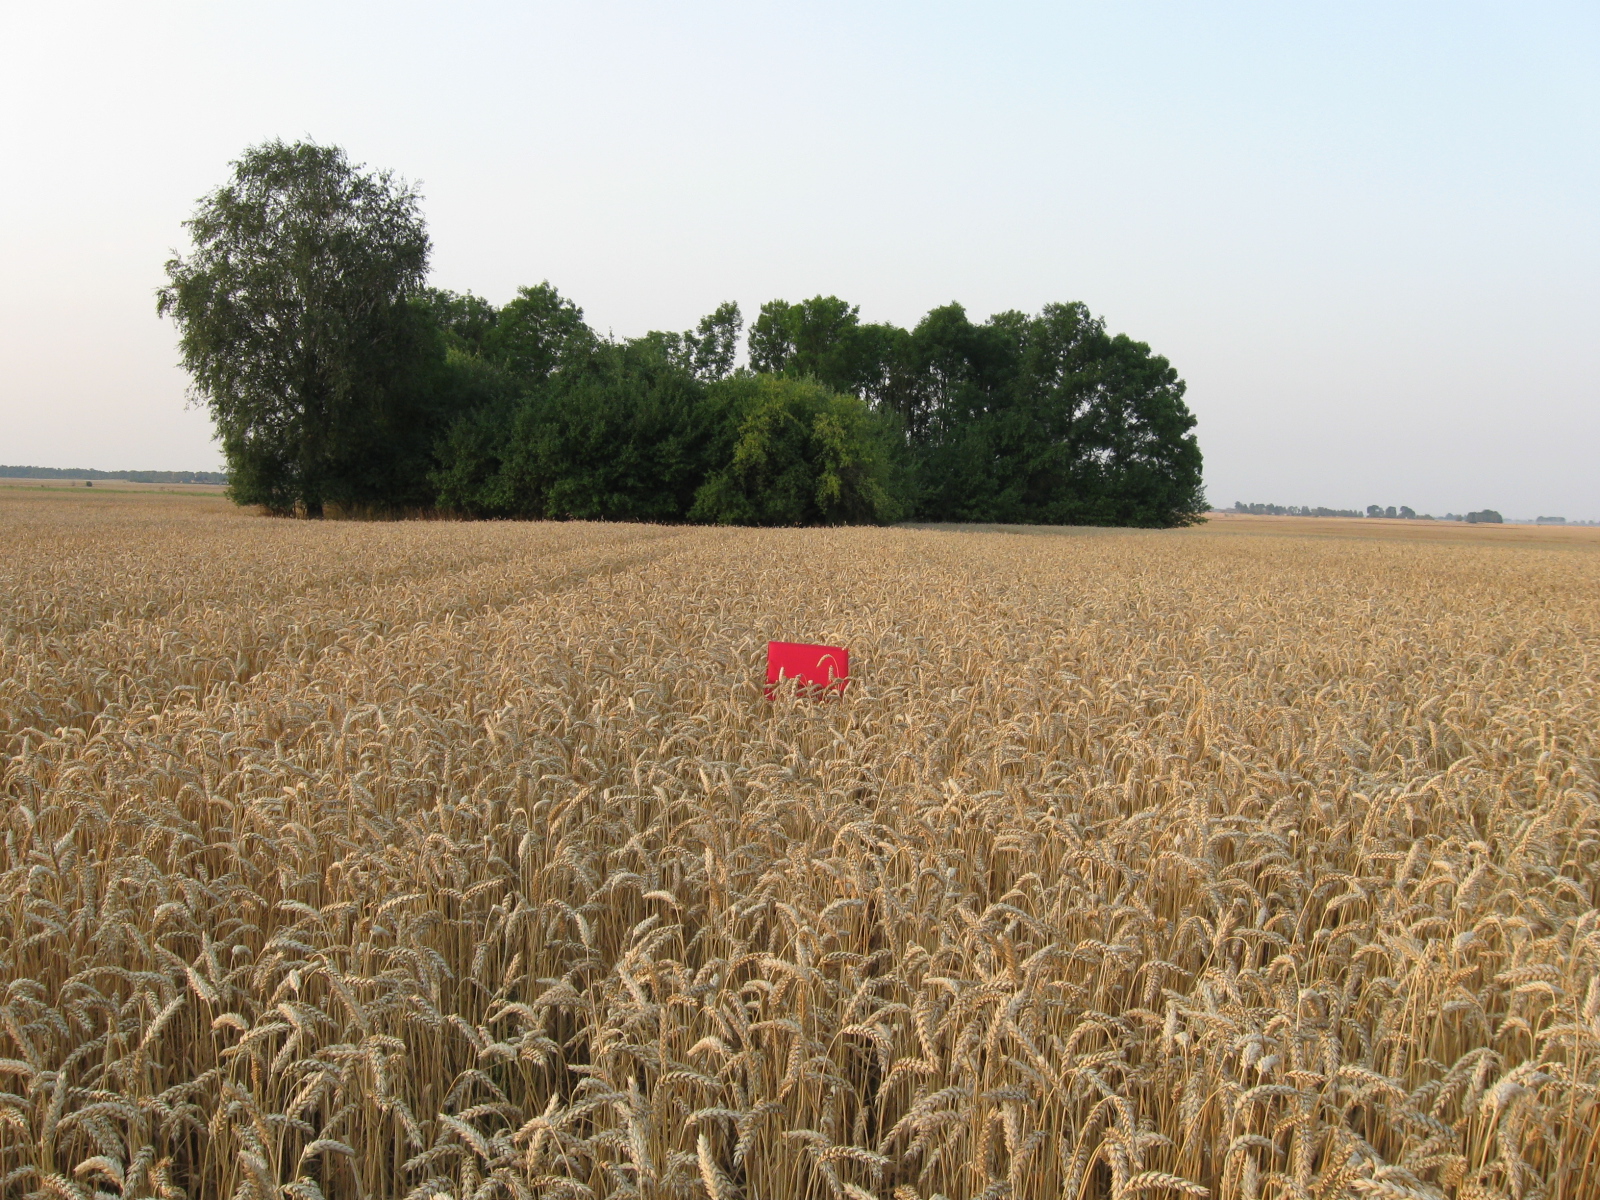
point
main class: Cropland
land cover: Common wheat
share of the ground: > 75 %
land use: Agriculture (excluding fallow land and kitchen gardens)
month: August
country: LT
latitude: 54.5431
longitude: 23.2942
